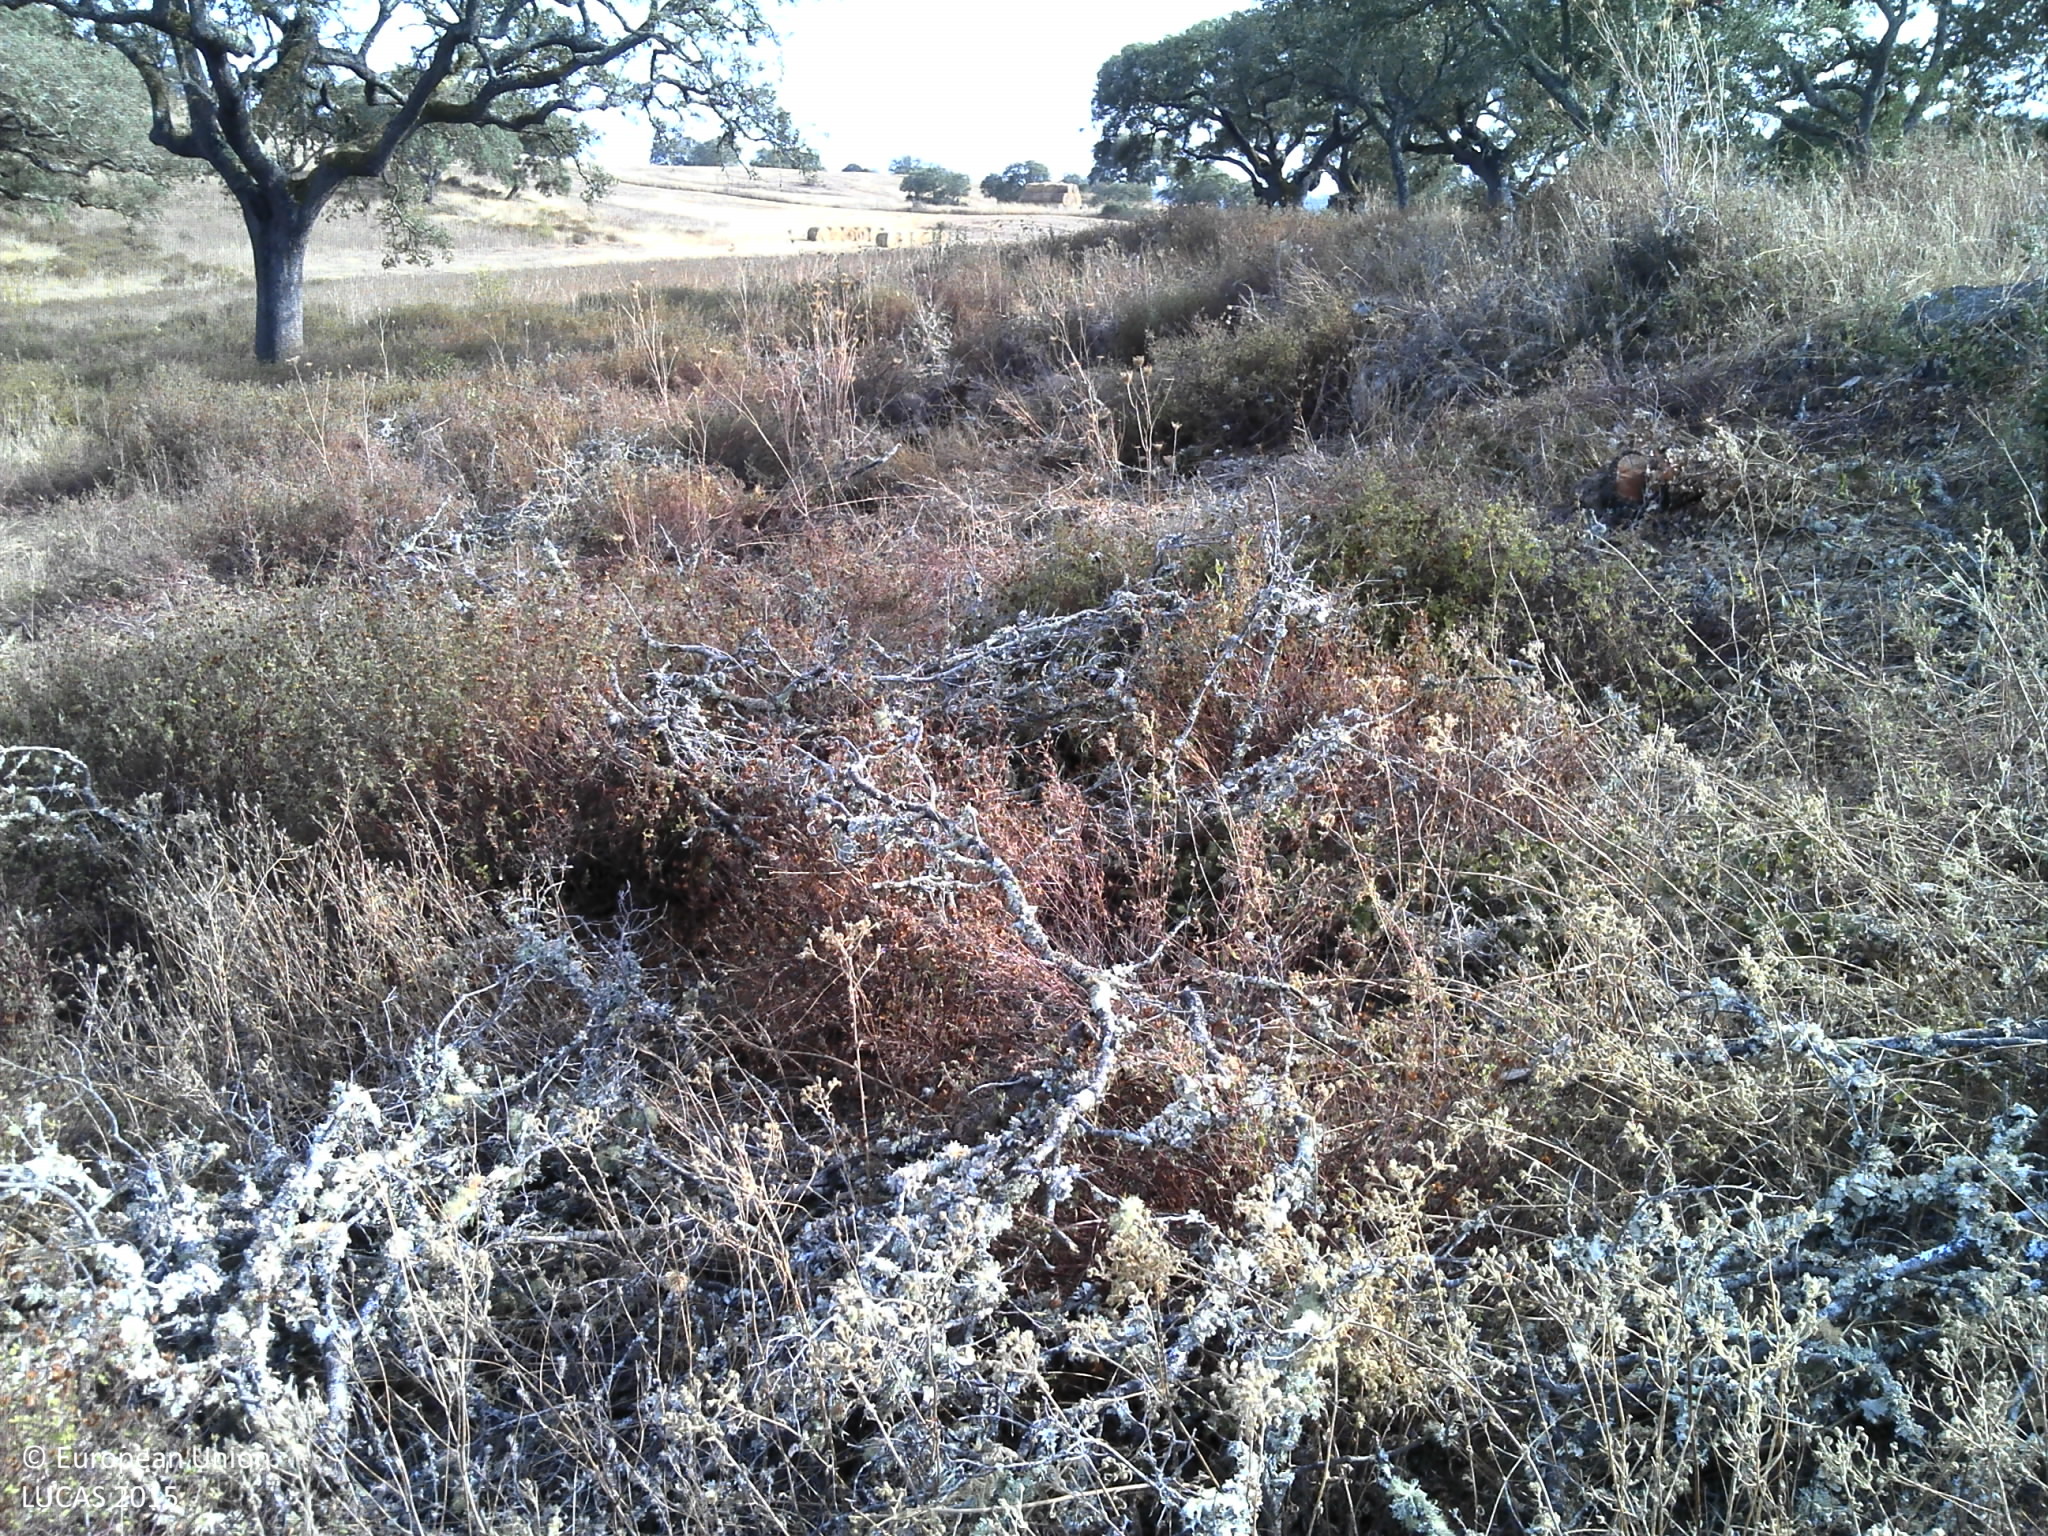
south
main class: Grassland
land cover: Grassland with sparse tree/shrub cover
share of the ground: > 75 %
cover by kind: herbaceous plants 80 %, consolidated bare surface 15 %, broadleaved forest trees 5 %
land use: Agriculture (excluding fallow land and kitchen gardens)
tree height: > 5 m
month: July
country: PT
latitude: 37.6302
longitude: -8.2613
